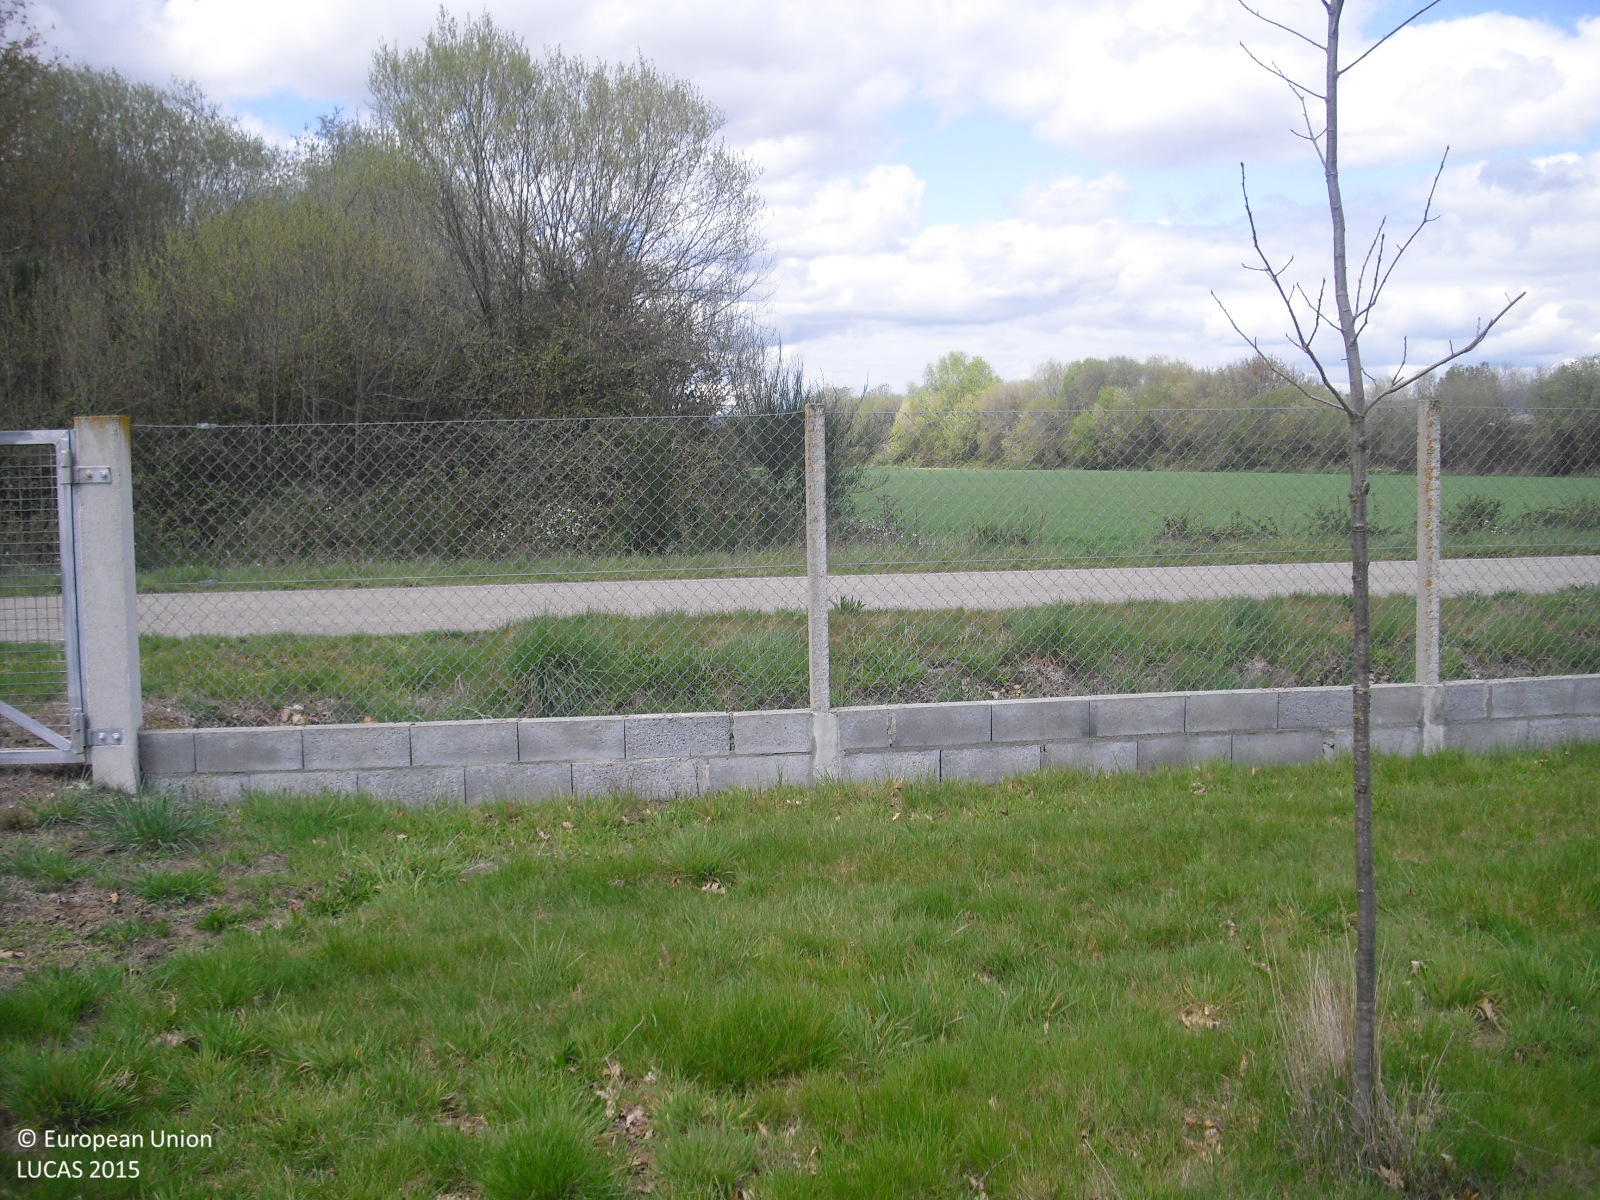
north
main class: Woodland
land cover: Broadleaved woodland
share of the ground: 10 - 25 %
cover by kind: herbaceous plants 80 %, broadleaved forest trees 20 %
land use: Forestry
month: April
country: ES
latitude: 42.0371
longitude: -7.8168
